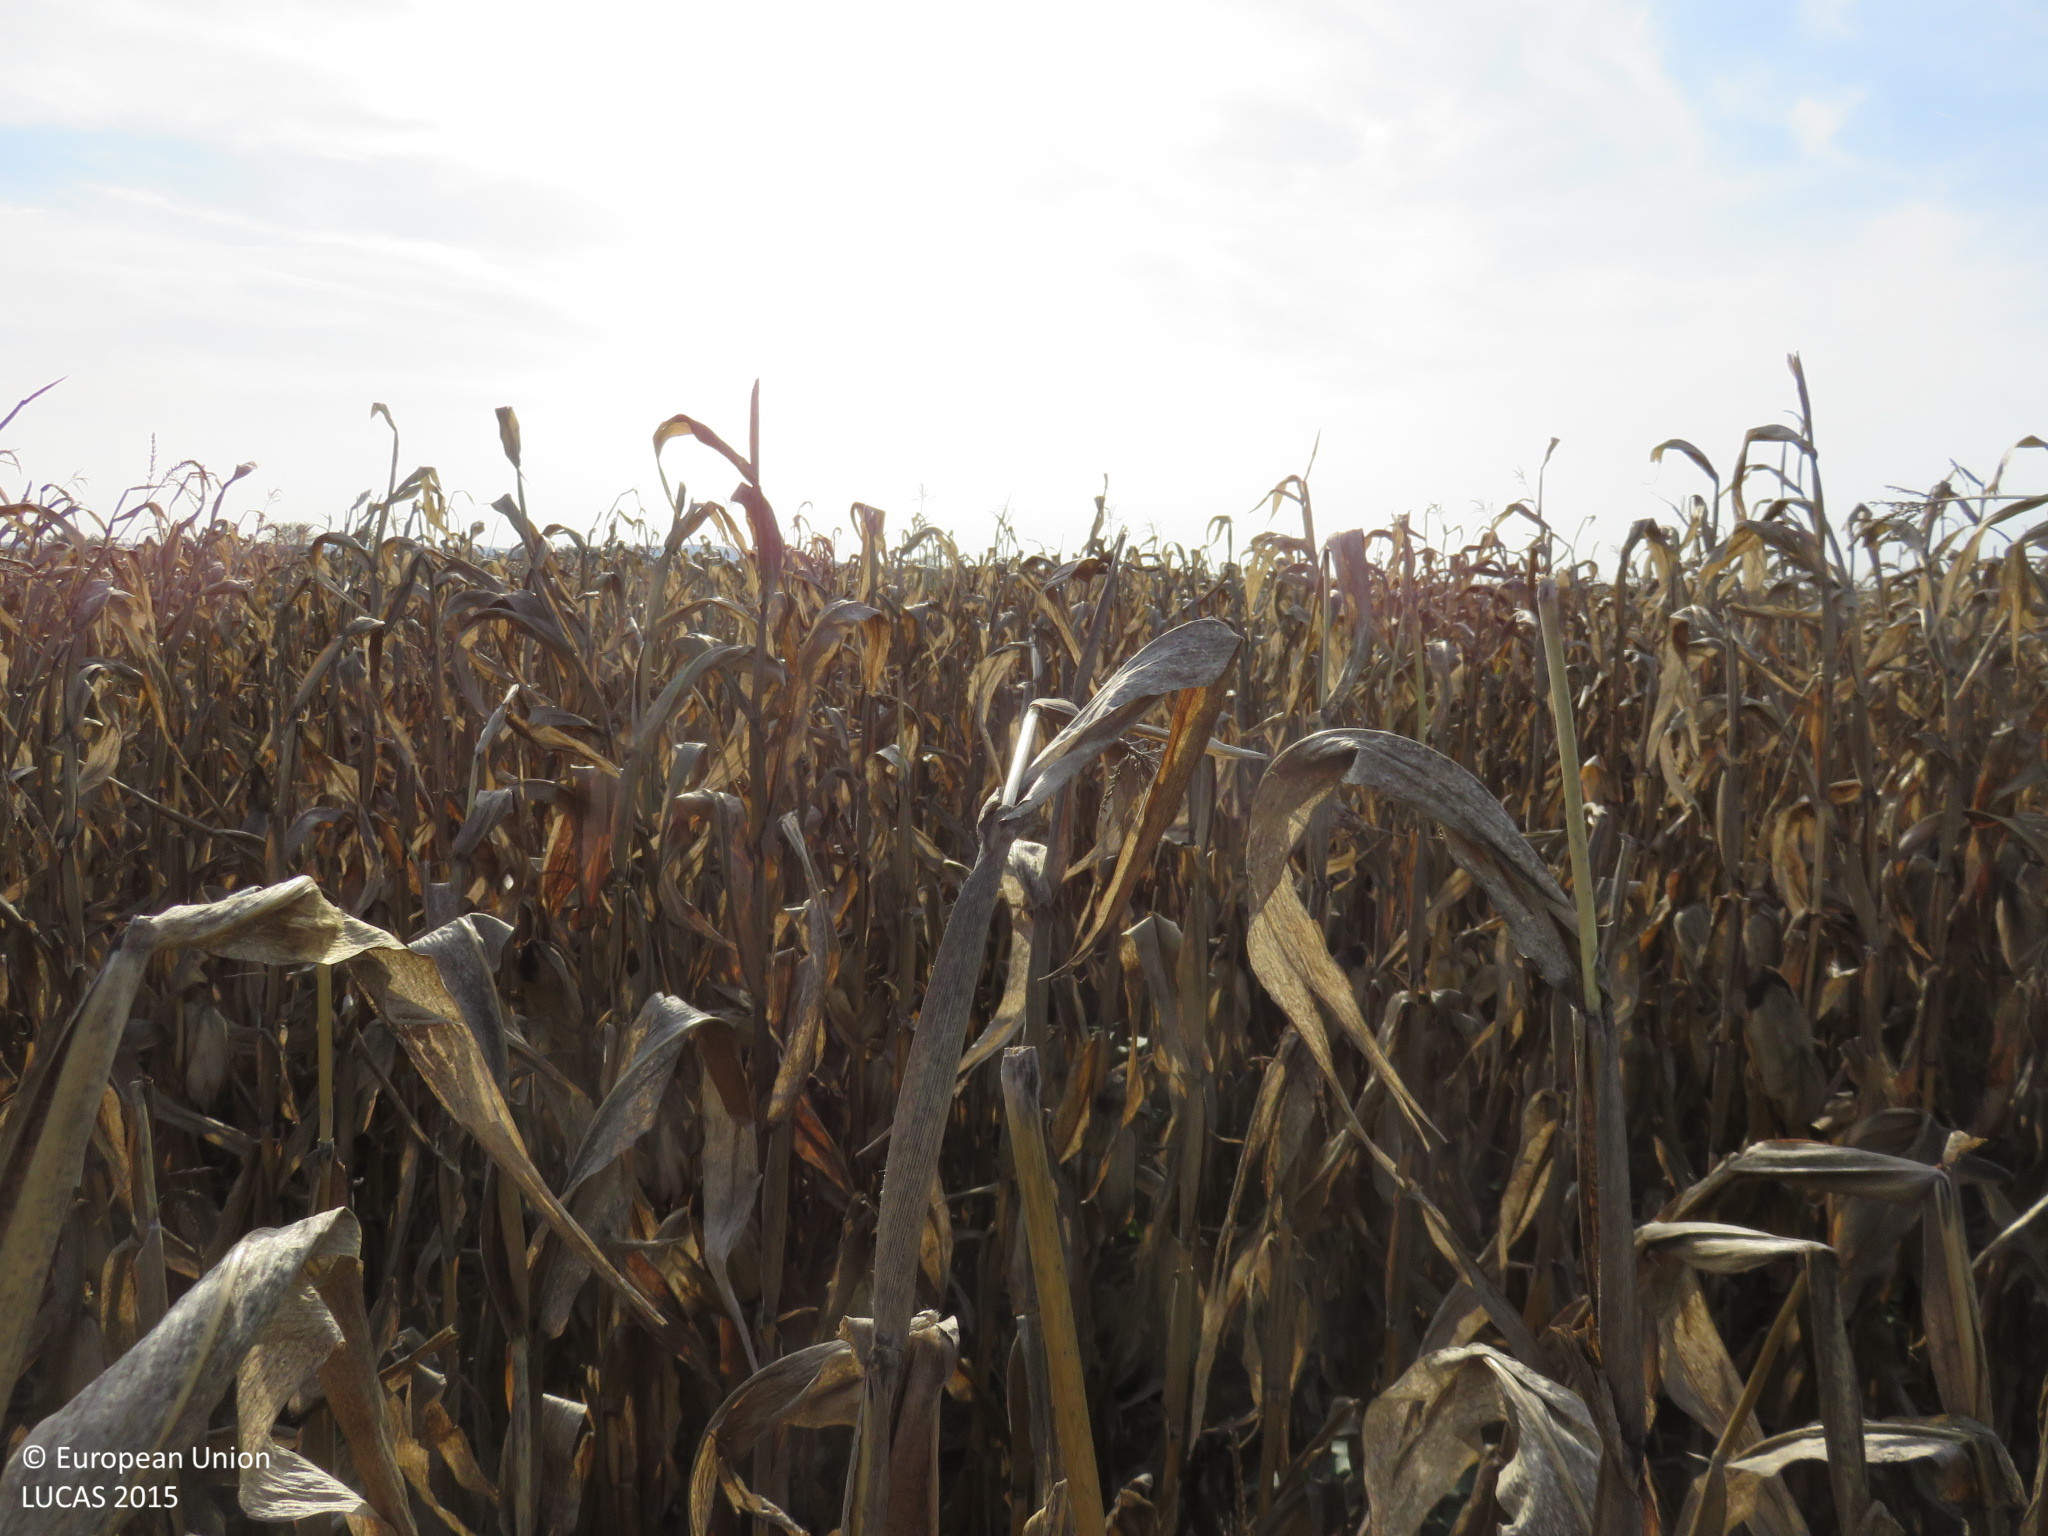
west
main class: Cropland
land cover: Maize
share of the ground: > 75 %
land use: Agriculture (excluding fallow land and kitchen gardens)
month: September
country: BG
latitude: 43.7282
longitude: 24.5018
